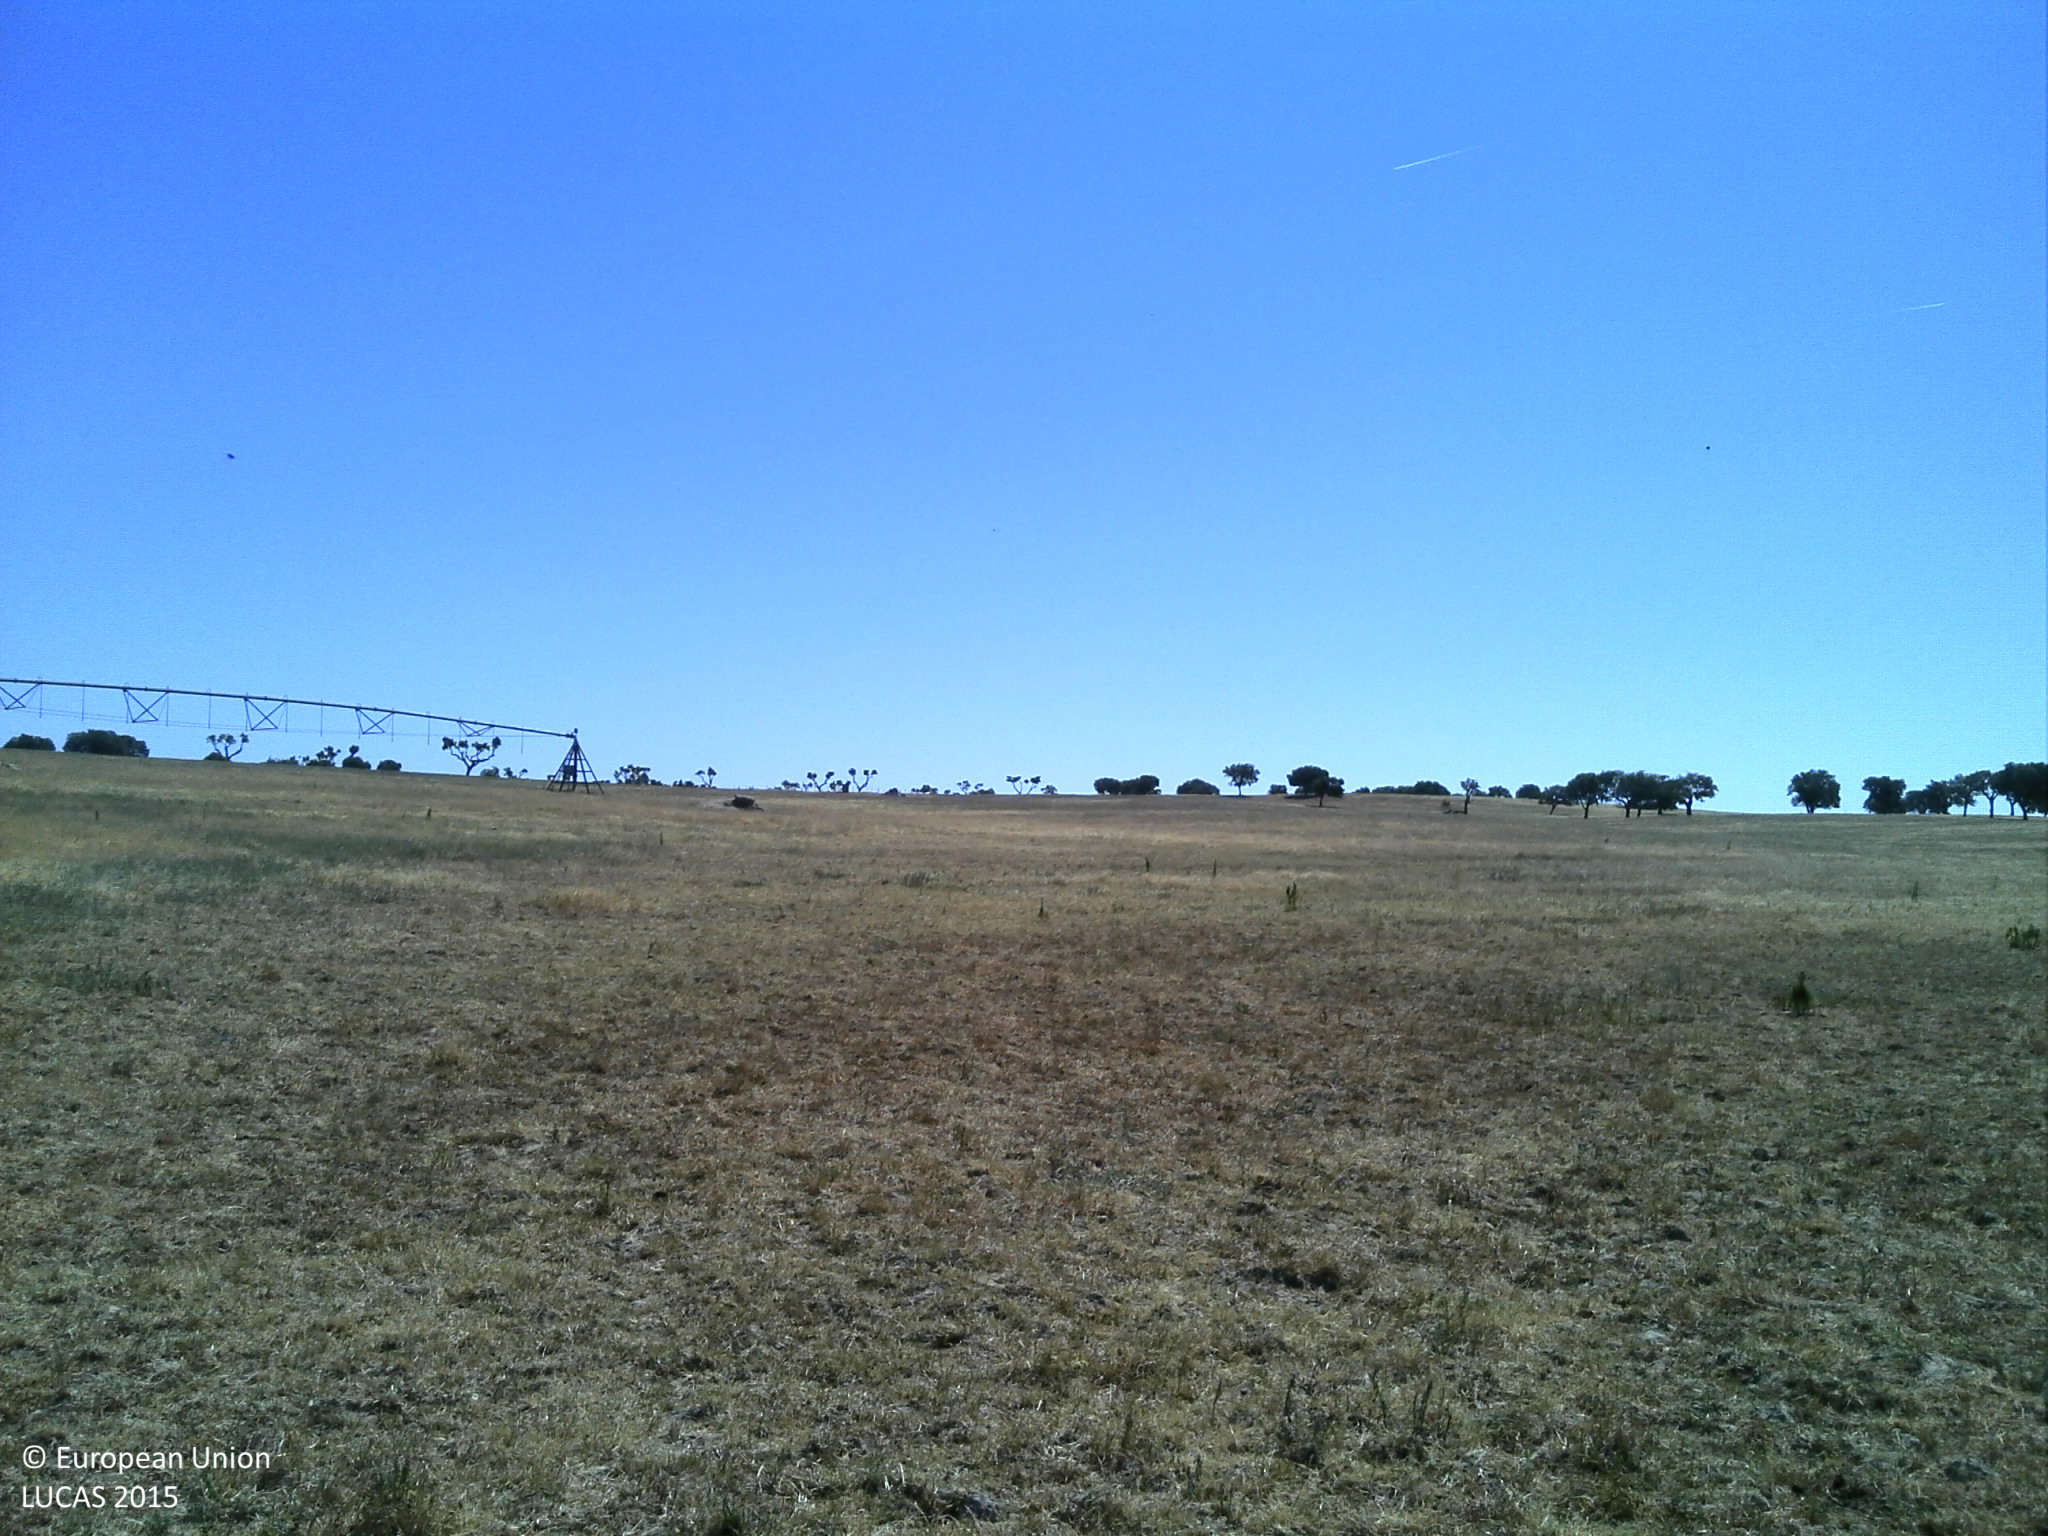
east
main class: Grassland
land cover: Spontaneously vegetated surfaces
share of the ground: > 75 %
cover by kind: herbaceous plants 75 %, unconsolidated bare surface 25 %
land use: Agriculture (excluding fallow land and kitchen gardens)
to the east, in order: Spontaneously vegetated surfaces; Rivers and streams; Spontaneously vegetated surfaces
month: June
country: PT
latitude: 38.7486
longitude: -8.2187
